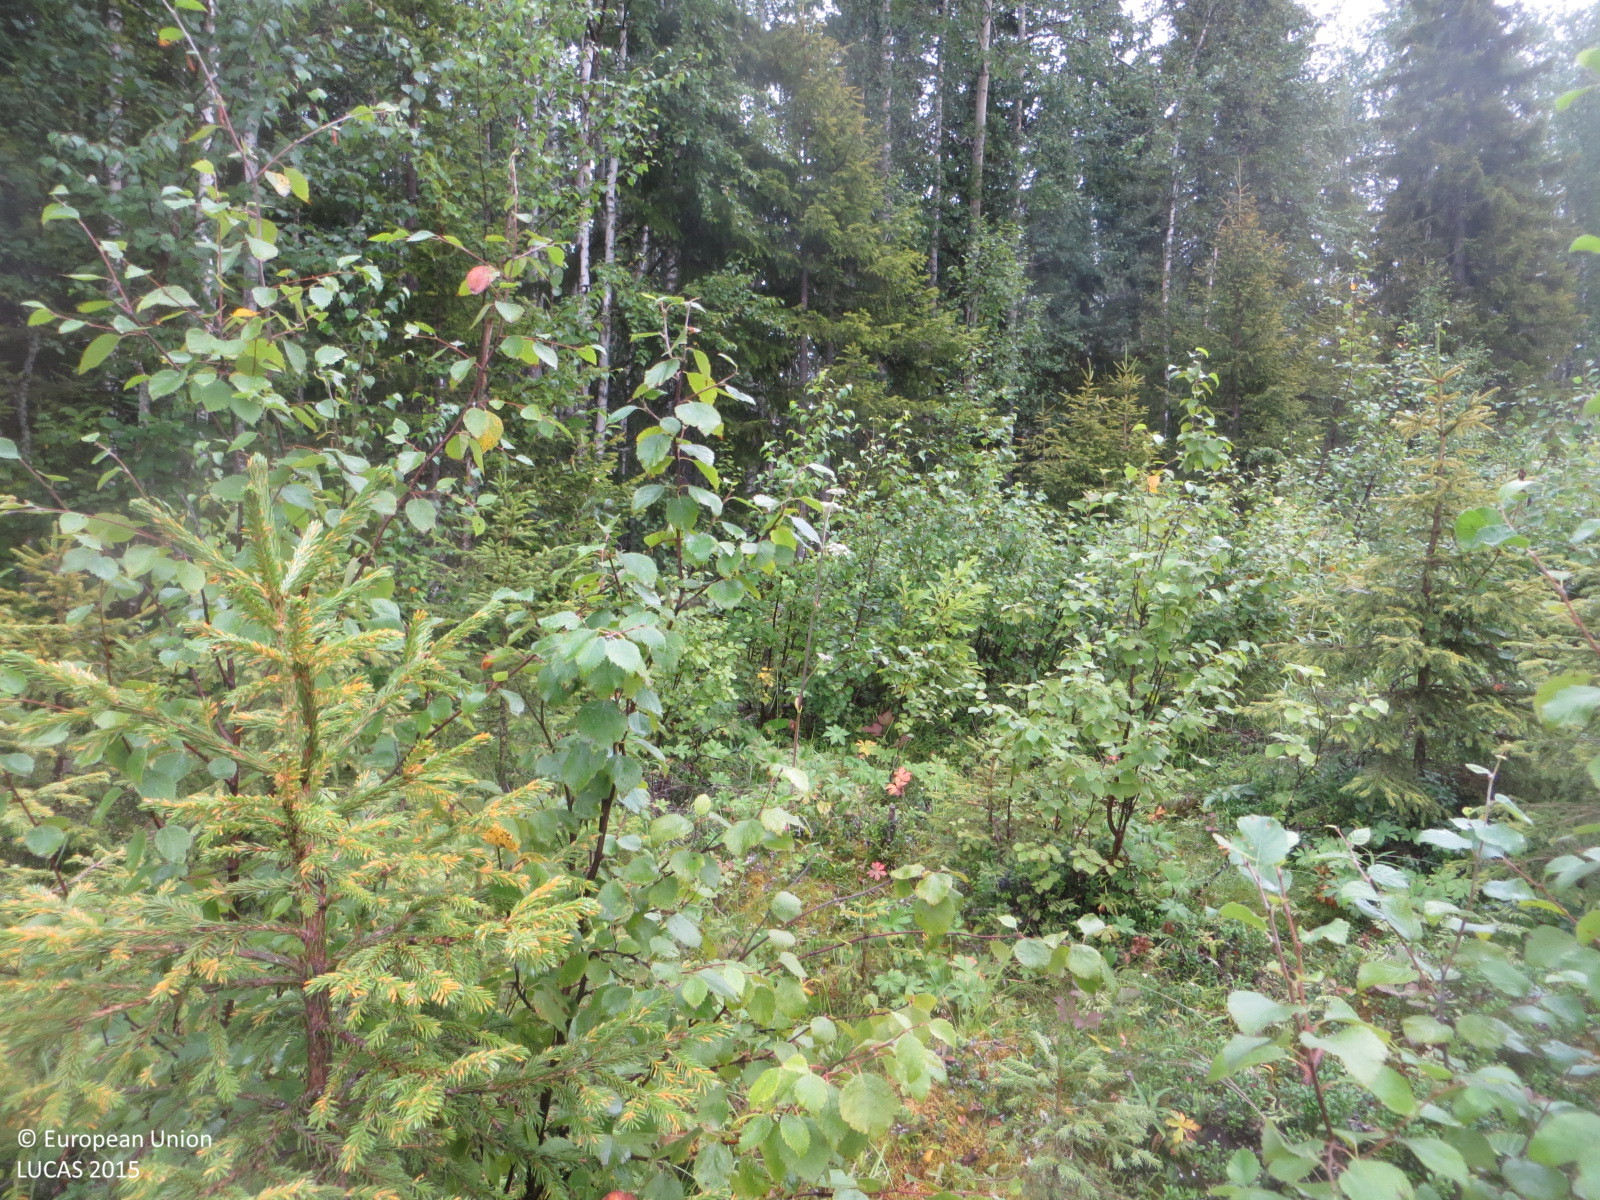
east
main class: Artificial land
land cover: Other artificial areas
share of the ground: > 75 %
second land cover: Other mixed woodland
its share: > 75 %
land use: Electricity, gas and thermal power distribution
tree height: < 5 m
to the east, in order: Artificial constructions in urban areas; Other mixed woodland; Electric lines; Other mixed woodland; Spruce dominated mixed woodland; Broadleaved woodland; Tracks; Spruce dominated mixed woodland; Other mixed woodland; Other coniferous woodland; Tracks; Shrubland with sparse tree cover
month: August
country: FI
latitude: 66.0928
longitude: 25.4824
